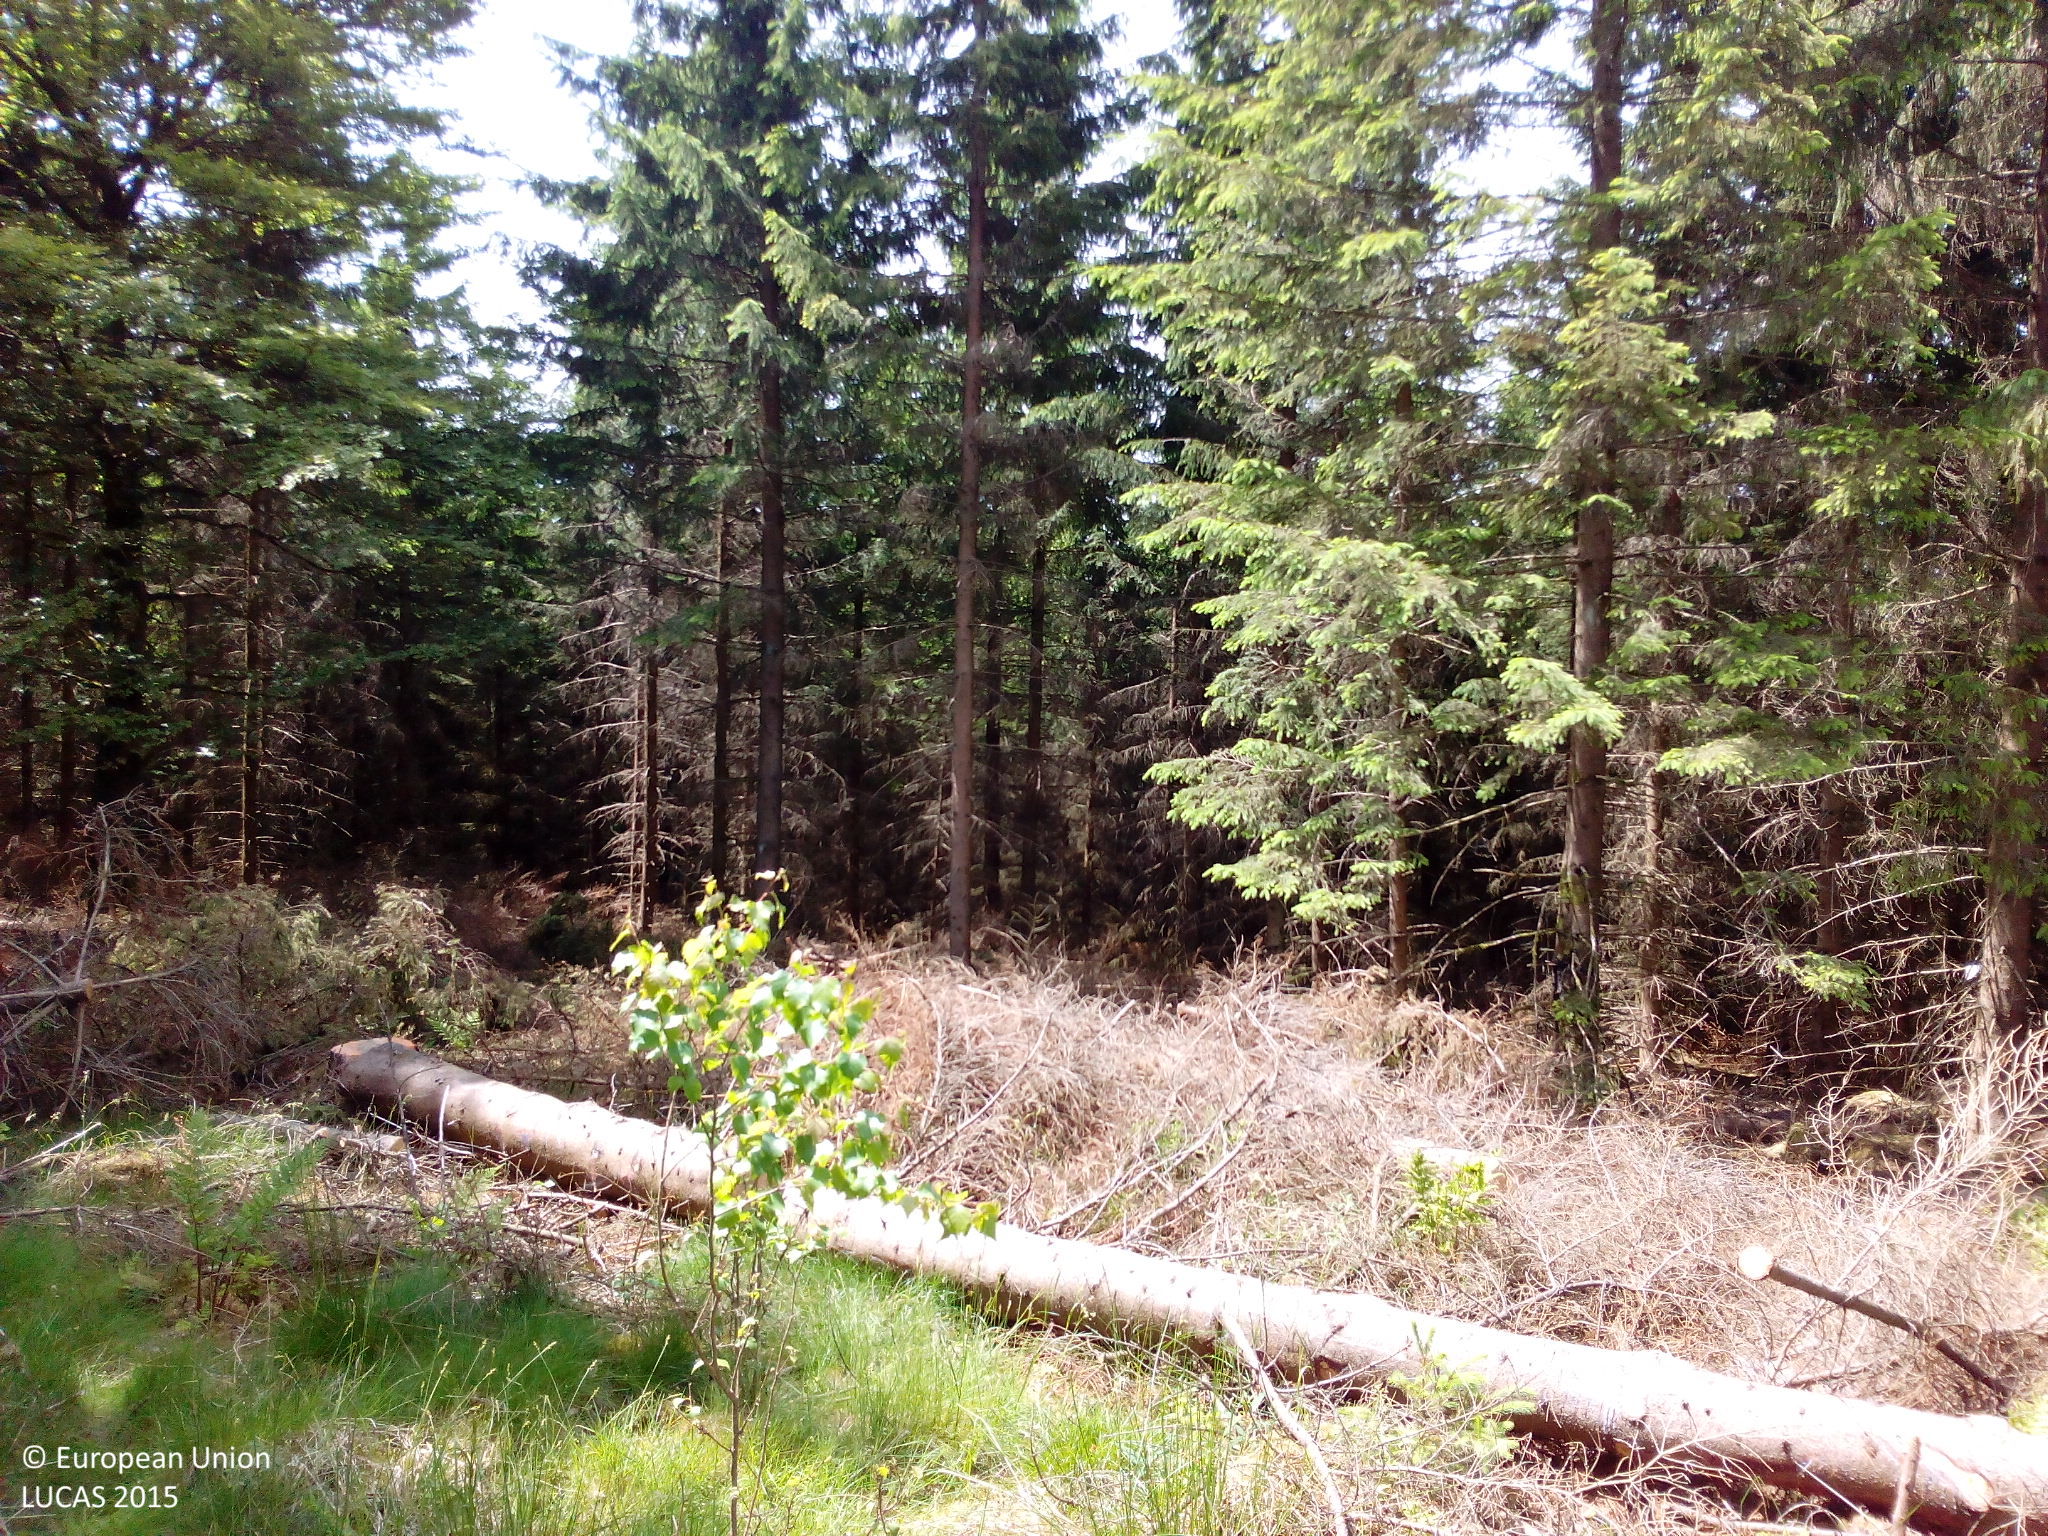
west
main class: Woodland
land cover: Spruce dominated mixed woodland
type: hemiboreal forest and nemoral coniferous forest and mixed broadleaved-coniferous forest
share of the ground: 50 - 75 %
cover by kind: coniferous forest trees 40 %, broadleaved forest trees 25 %, herbaceous plants 20 %, shrubs 15 %
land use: Forestry
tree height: > 5 m
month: June
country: DE
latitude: 51.3967
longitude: 8.4625
